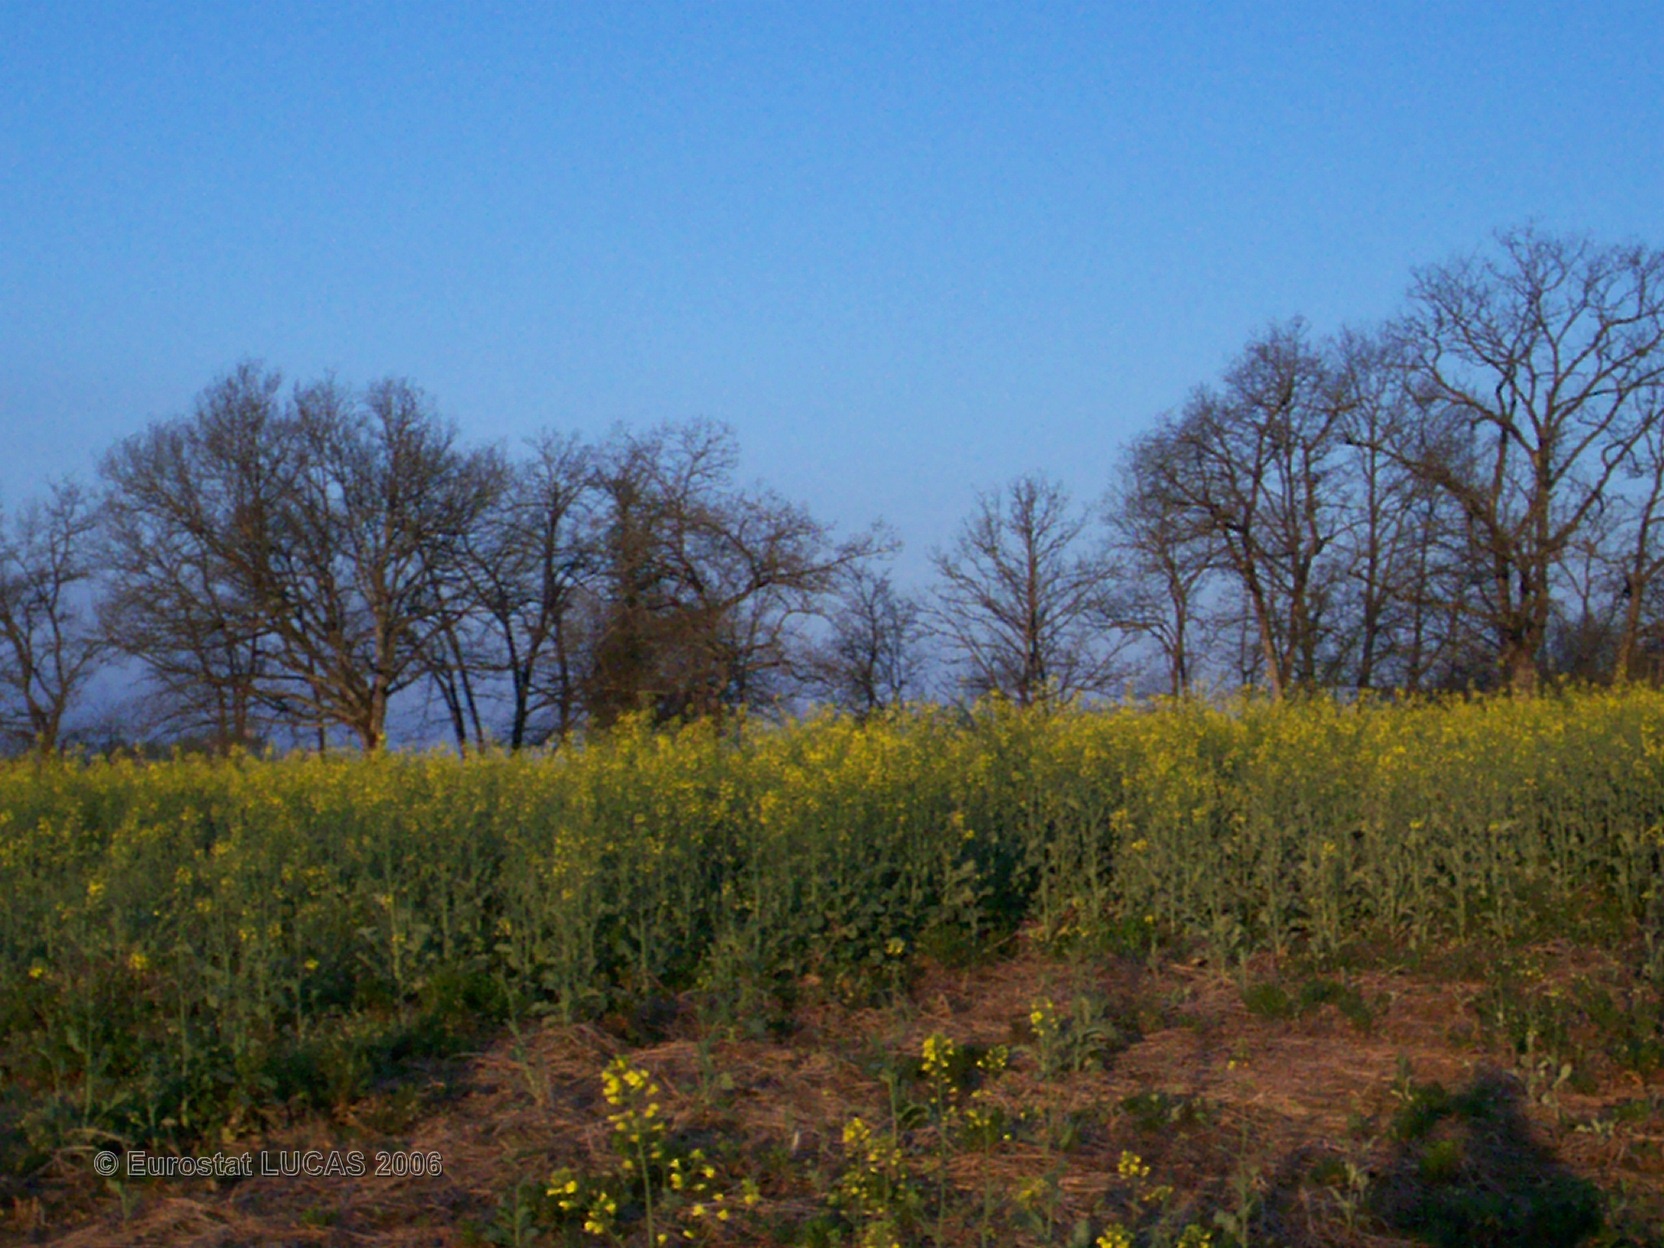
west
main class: Cropland
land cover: Rape and turnip rape
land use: Agriculture (excluding fallow land and kitchen gardens)
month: April
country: FR
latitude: 43.5078
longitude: 0.2371
